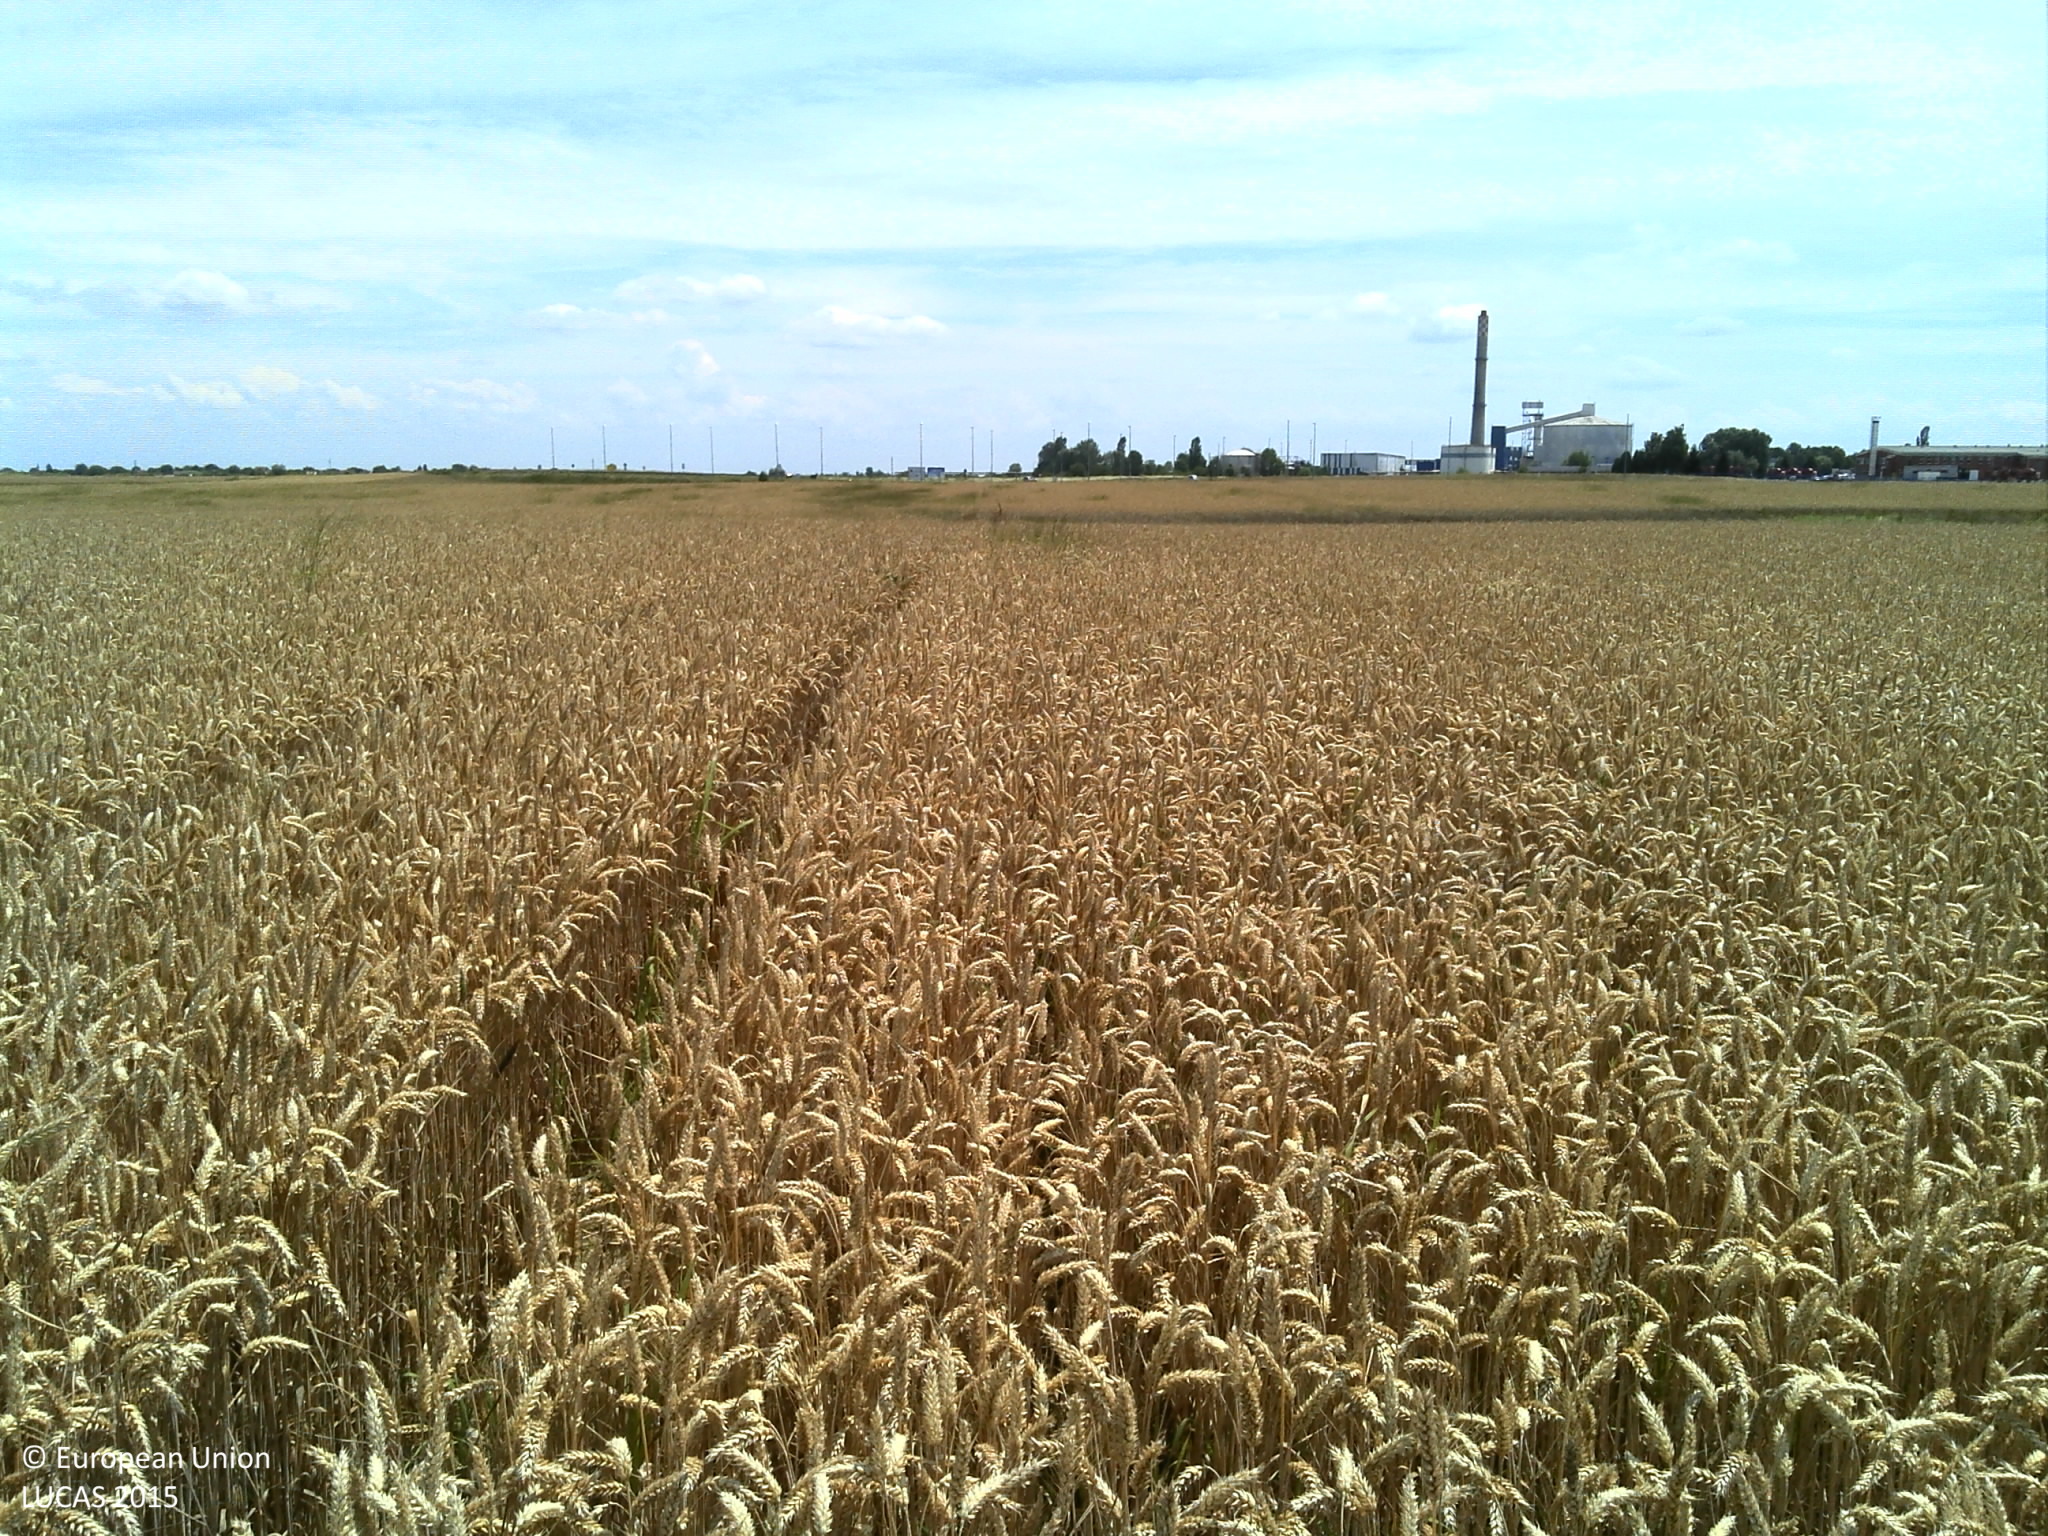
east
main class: Cropland
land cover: Common wheat
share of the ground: > 75 %
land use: Agriculture (excluding fallow land and kitchen gardens)
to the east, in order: Common wheat
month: June
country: HR
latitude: 45.8608
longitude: 17.3827
